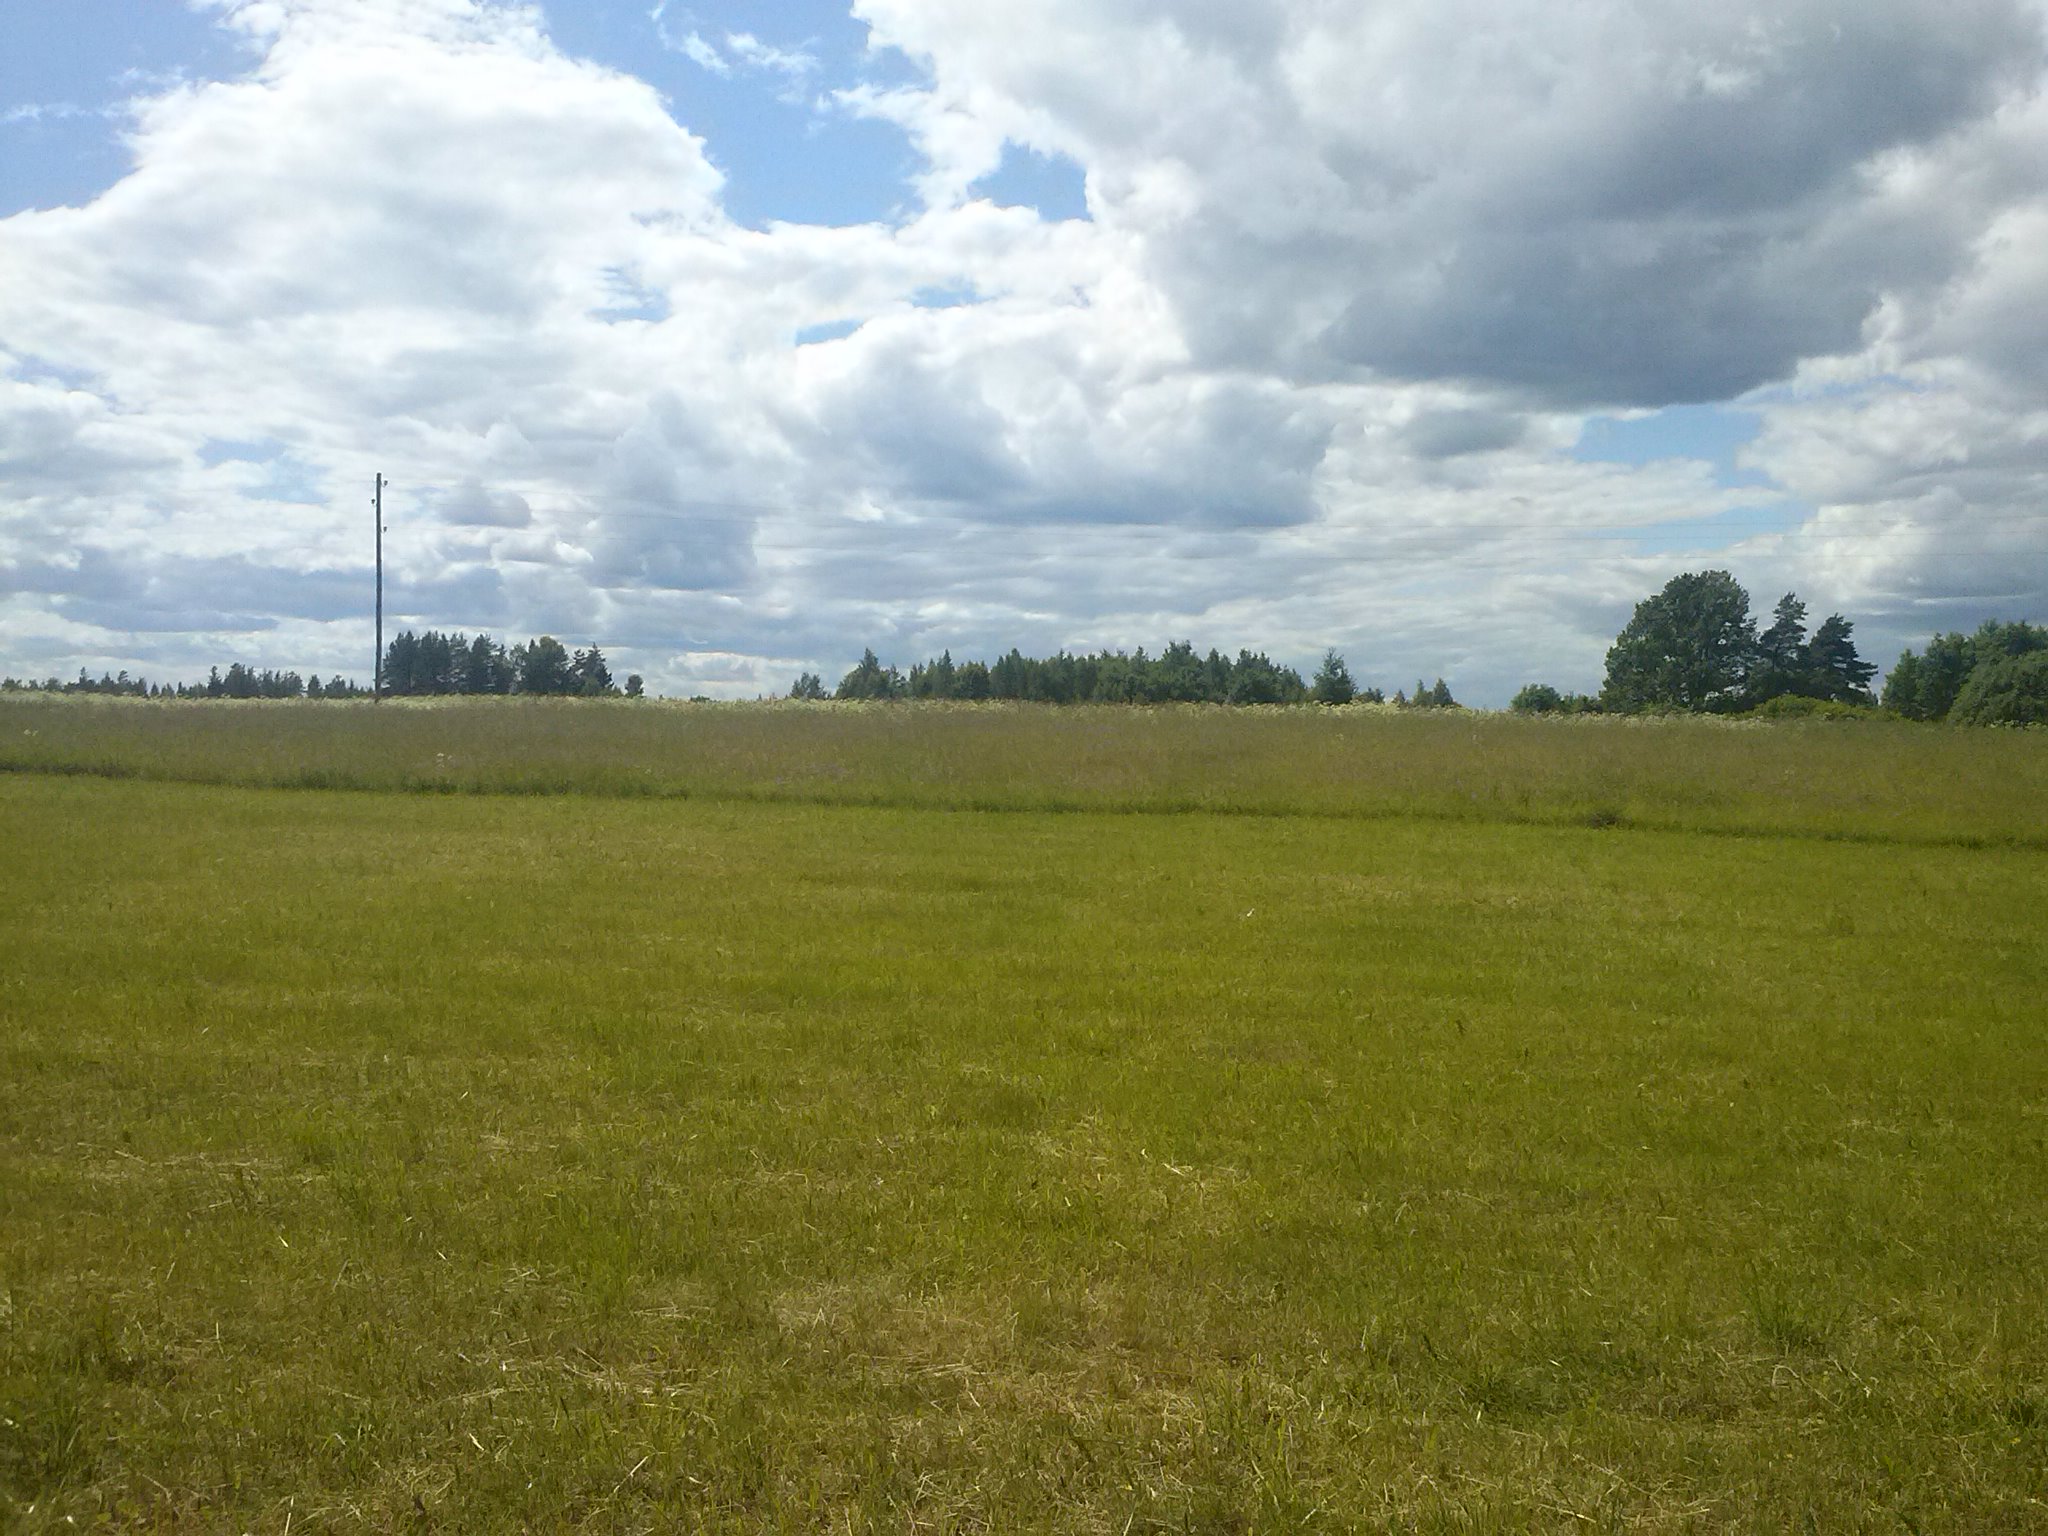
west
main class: Grassland
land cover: Grassland without tree/shrub cover
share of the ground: > 75 %
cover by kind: herbaceous plants 100 %
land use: Agriculture (excluding fallow land and kitchen gardens)
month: June
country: LV
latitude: 56.3877
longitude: 27.6623
